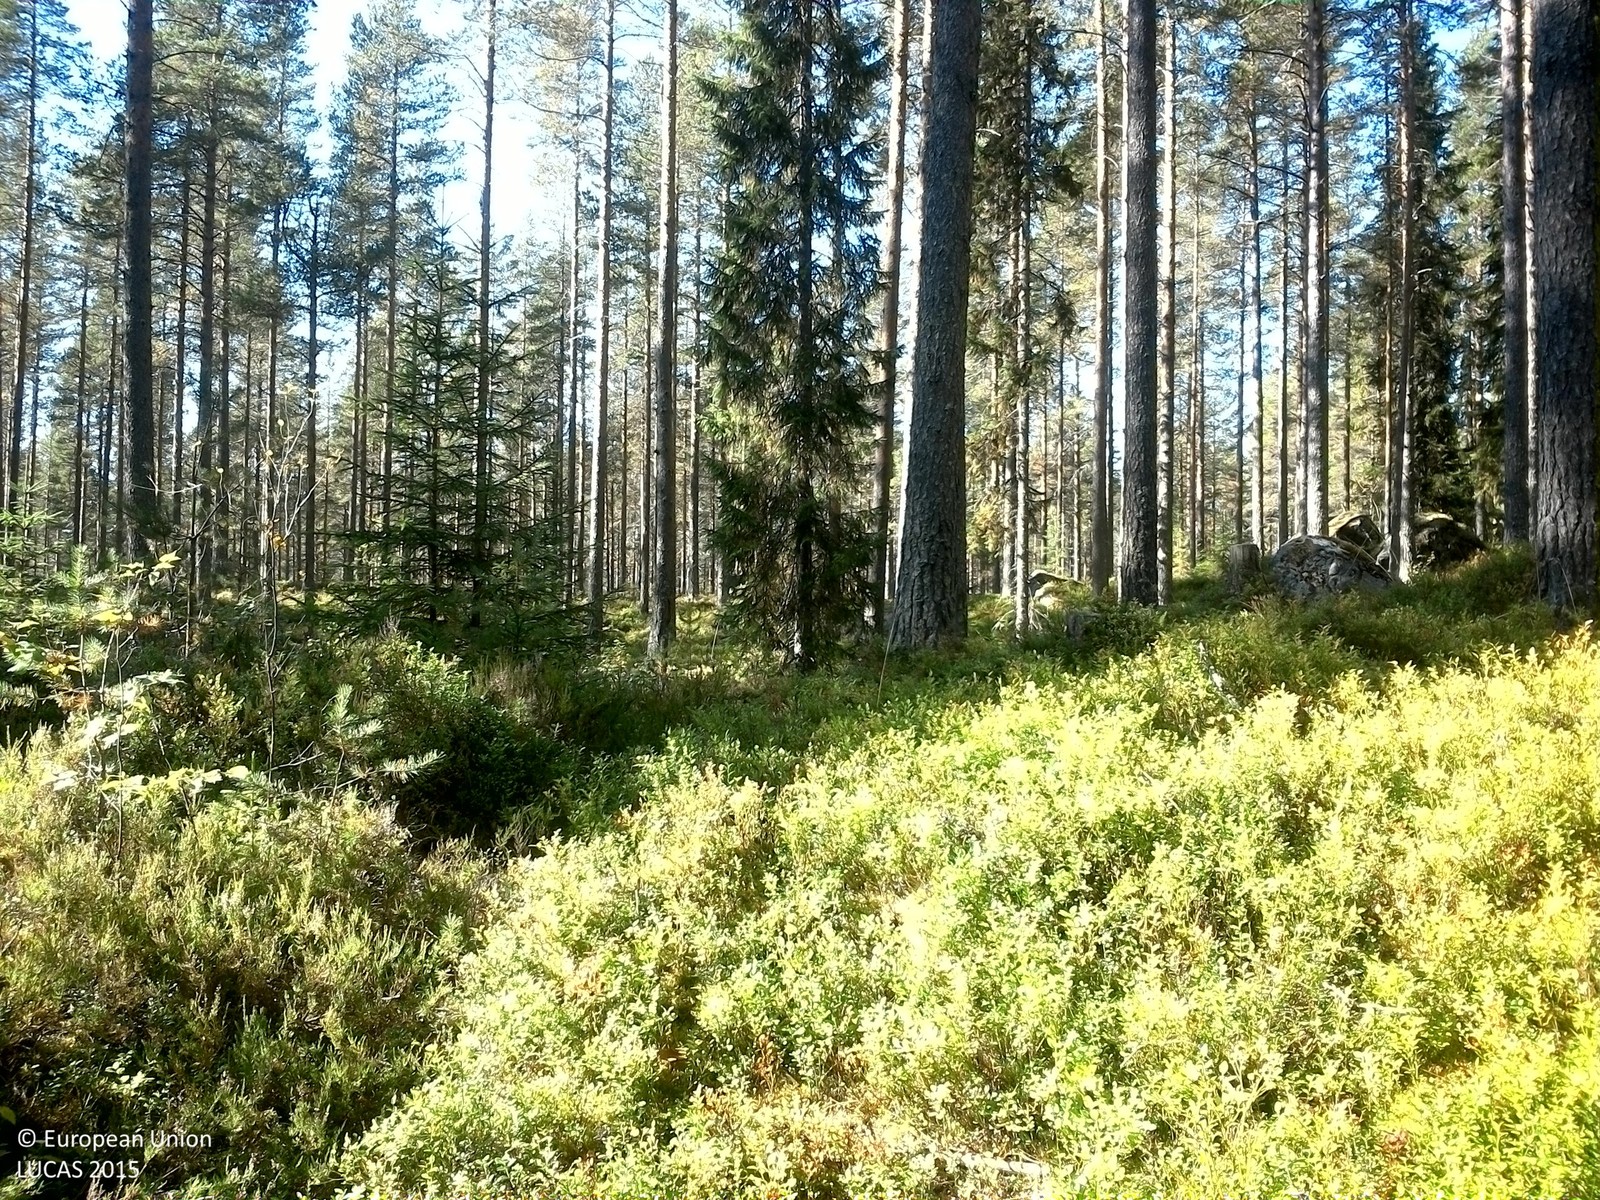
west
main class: Woodland
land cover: Pine dominated coniferous woodland
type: boreal forest
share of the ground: 50 - 75 %
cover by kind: coniferous forest trees 50 %, shrubs 35 %, lichens and mosses 15 %
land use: Forestry
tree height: > 5 m
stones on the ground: 10 - 25 %
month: September
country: SE
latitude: 61.7551
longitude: 14.9274
